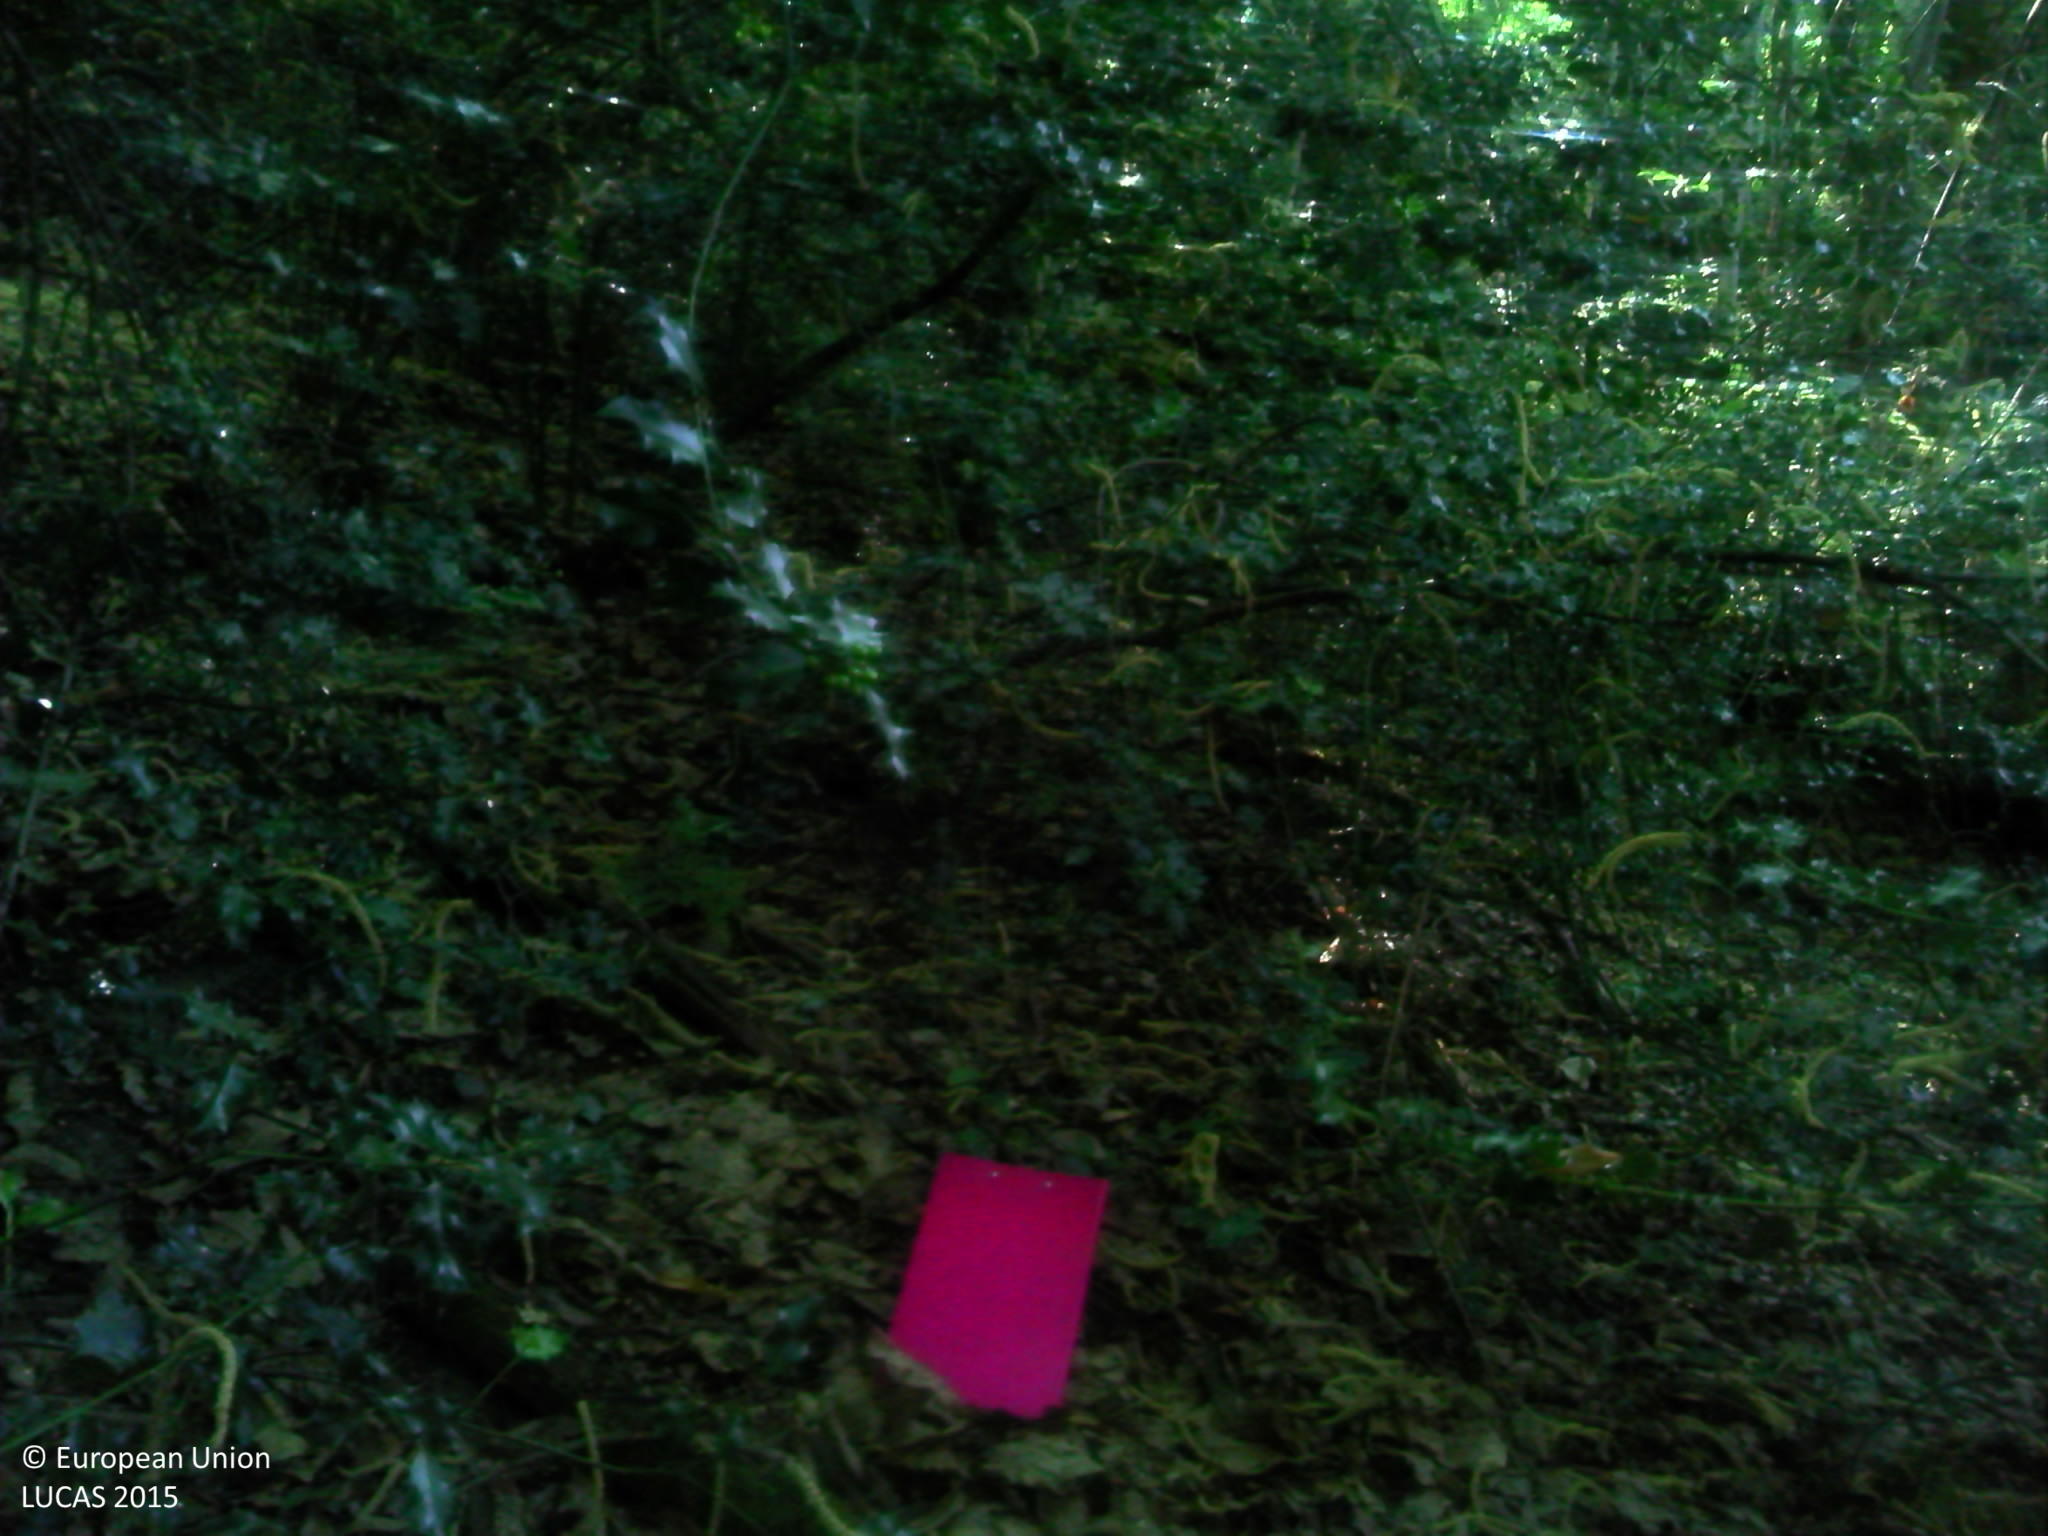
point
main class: Woodland
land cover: Broadleaved woodland
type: mesophytic deciduous forest
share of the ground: > 75 %
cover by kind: broadleaved forest trees 100 %
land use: Forestry
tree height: > 5 m
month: July
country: FR
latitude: 46.2694
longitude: 1.5438
